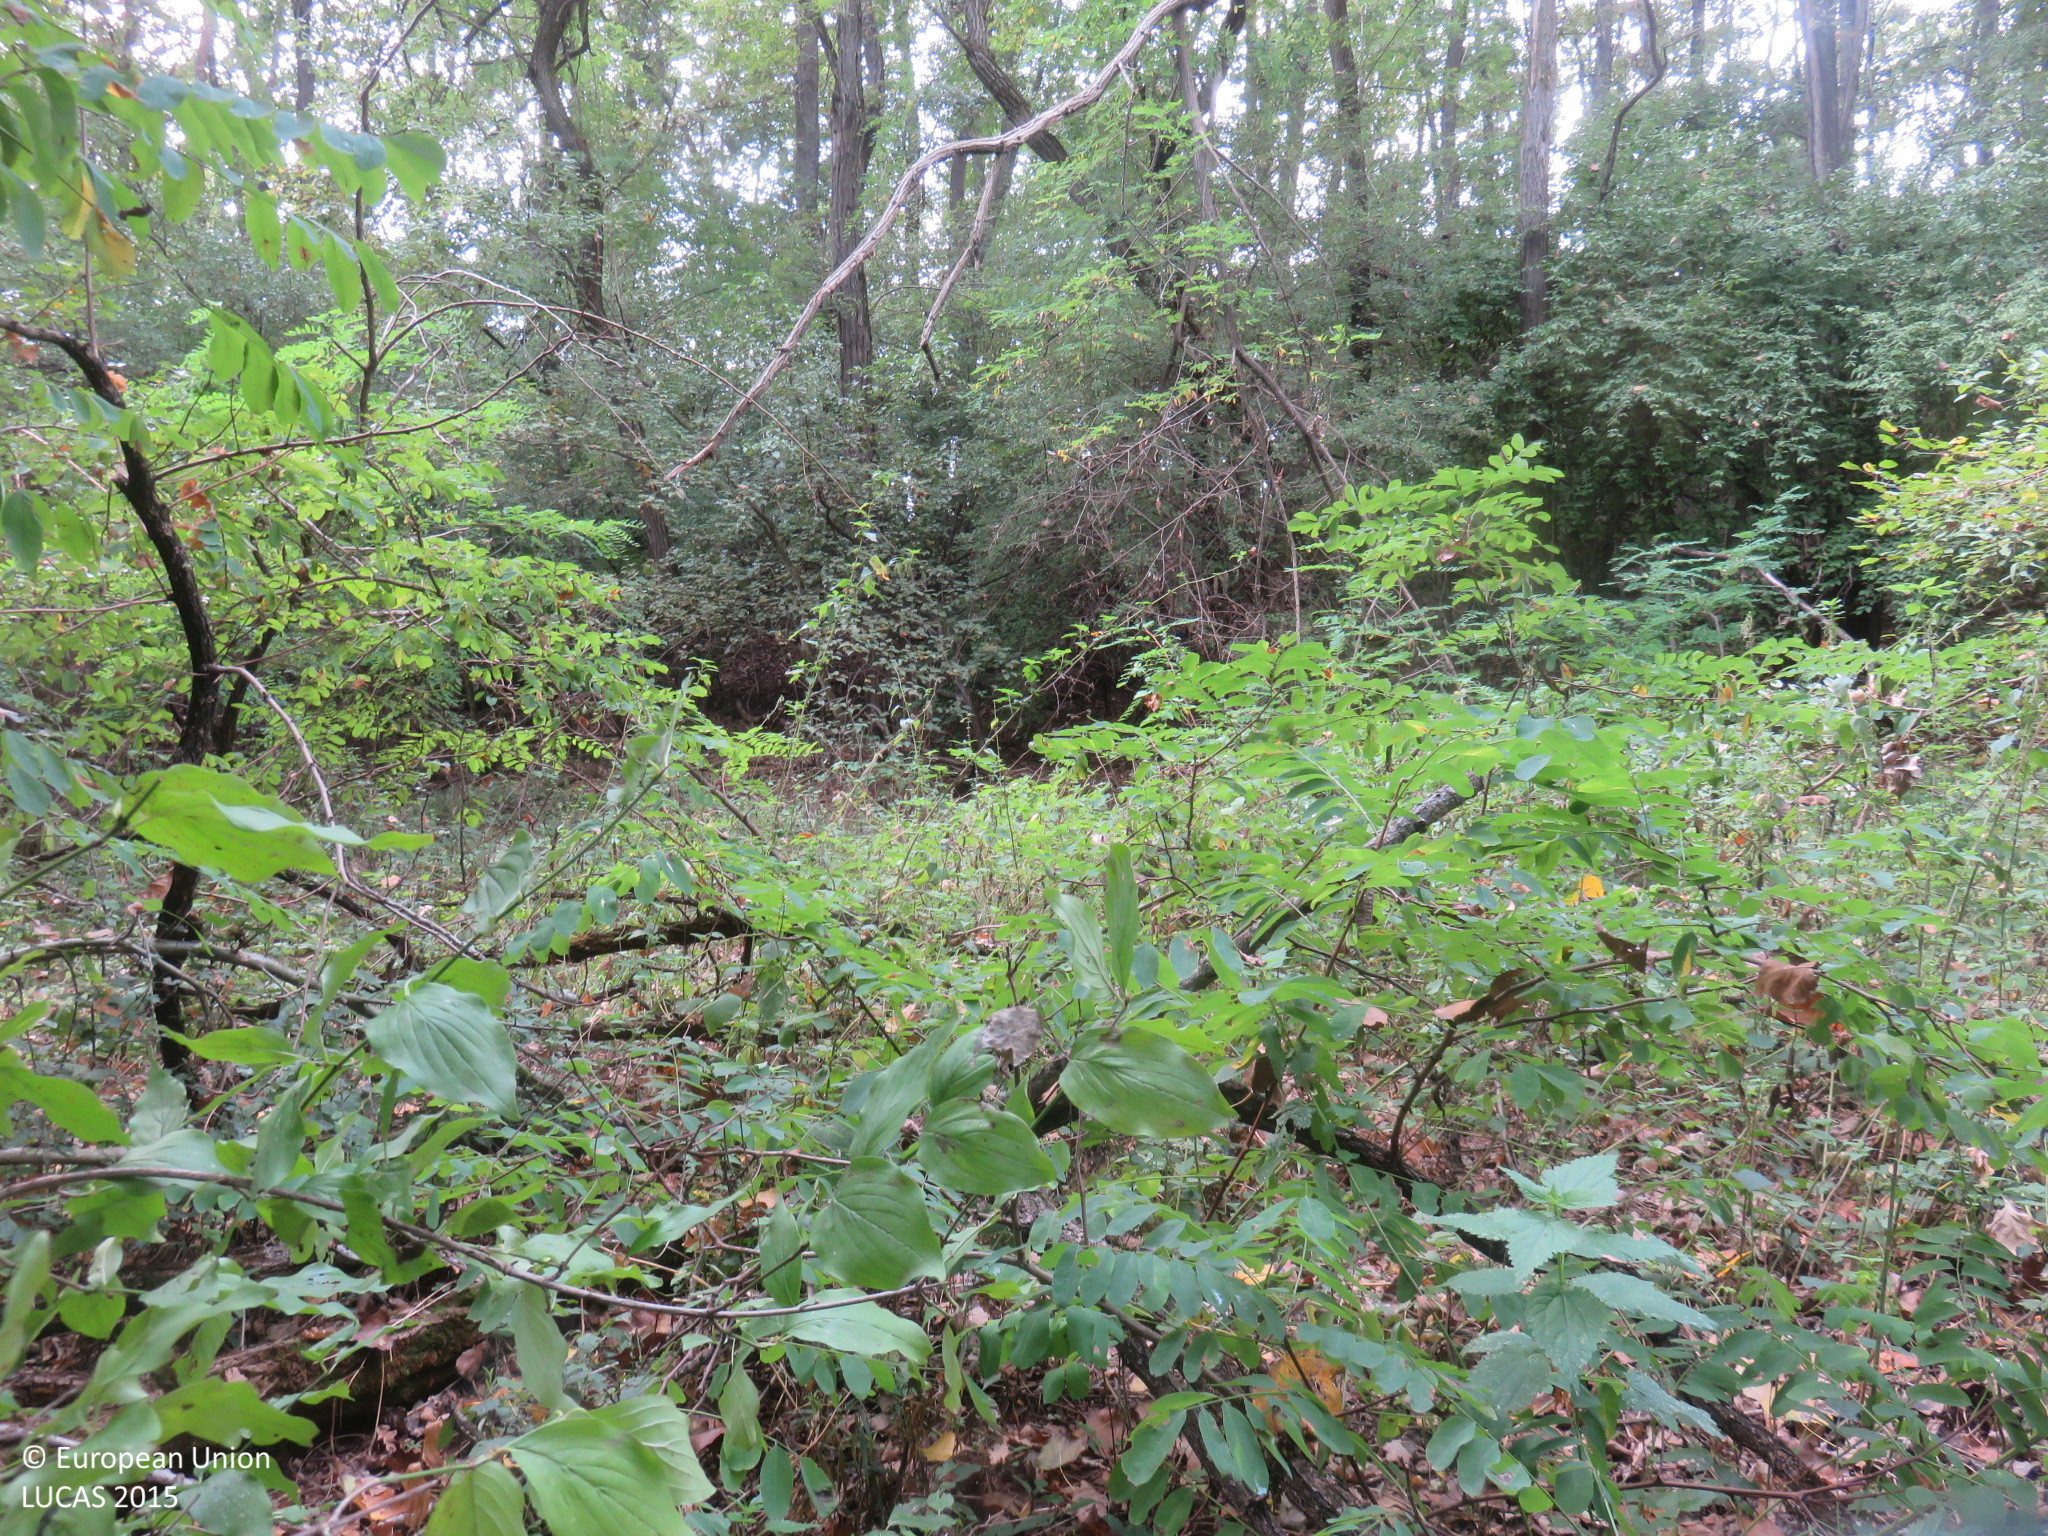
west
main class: Woodland
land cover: Broadleaved woodland
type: mesophytic deciduous forest
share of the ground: > 75 %
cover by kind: broadleaved forest trees 90 %, shrubs 5 %, herbaceous plants 5 %
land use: Forestry
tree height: < 5 m
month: September
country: BG
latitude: 43.0857
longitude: 24.8913
